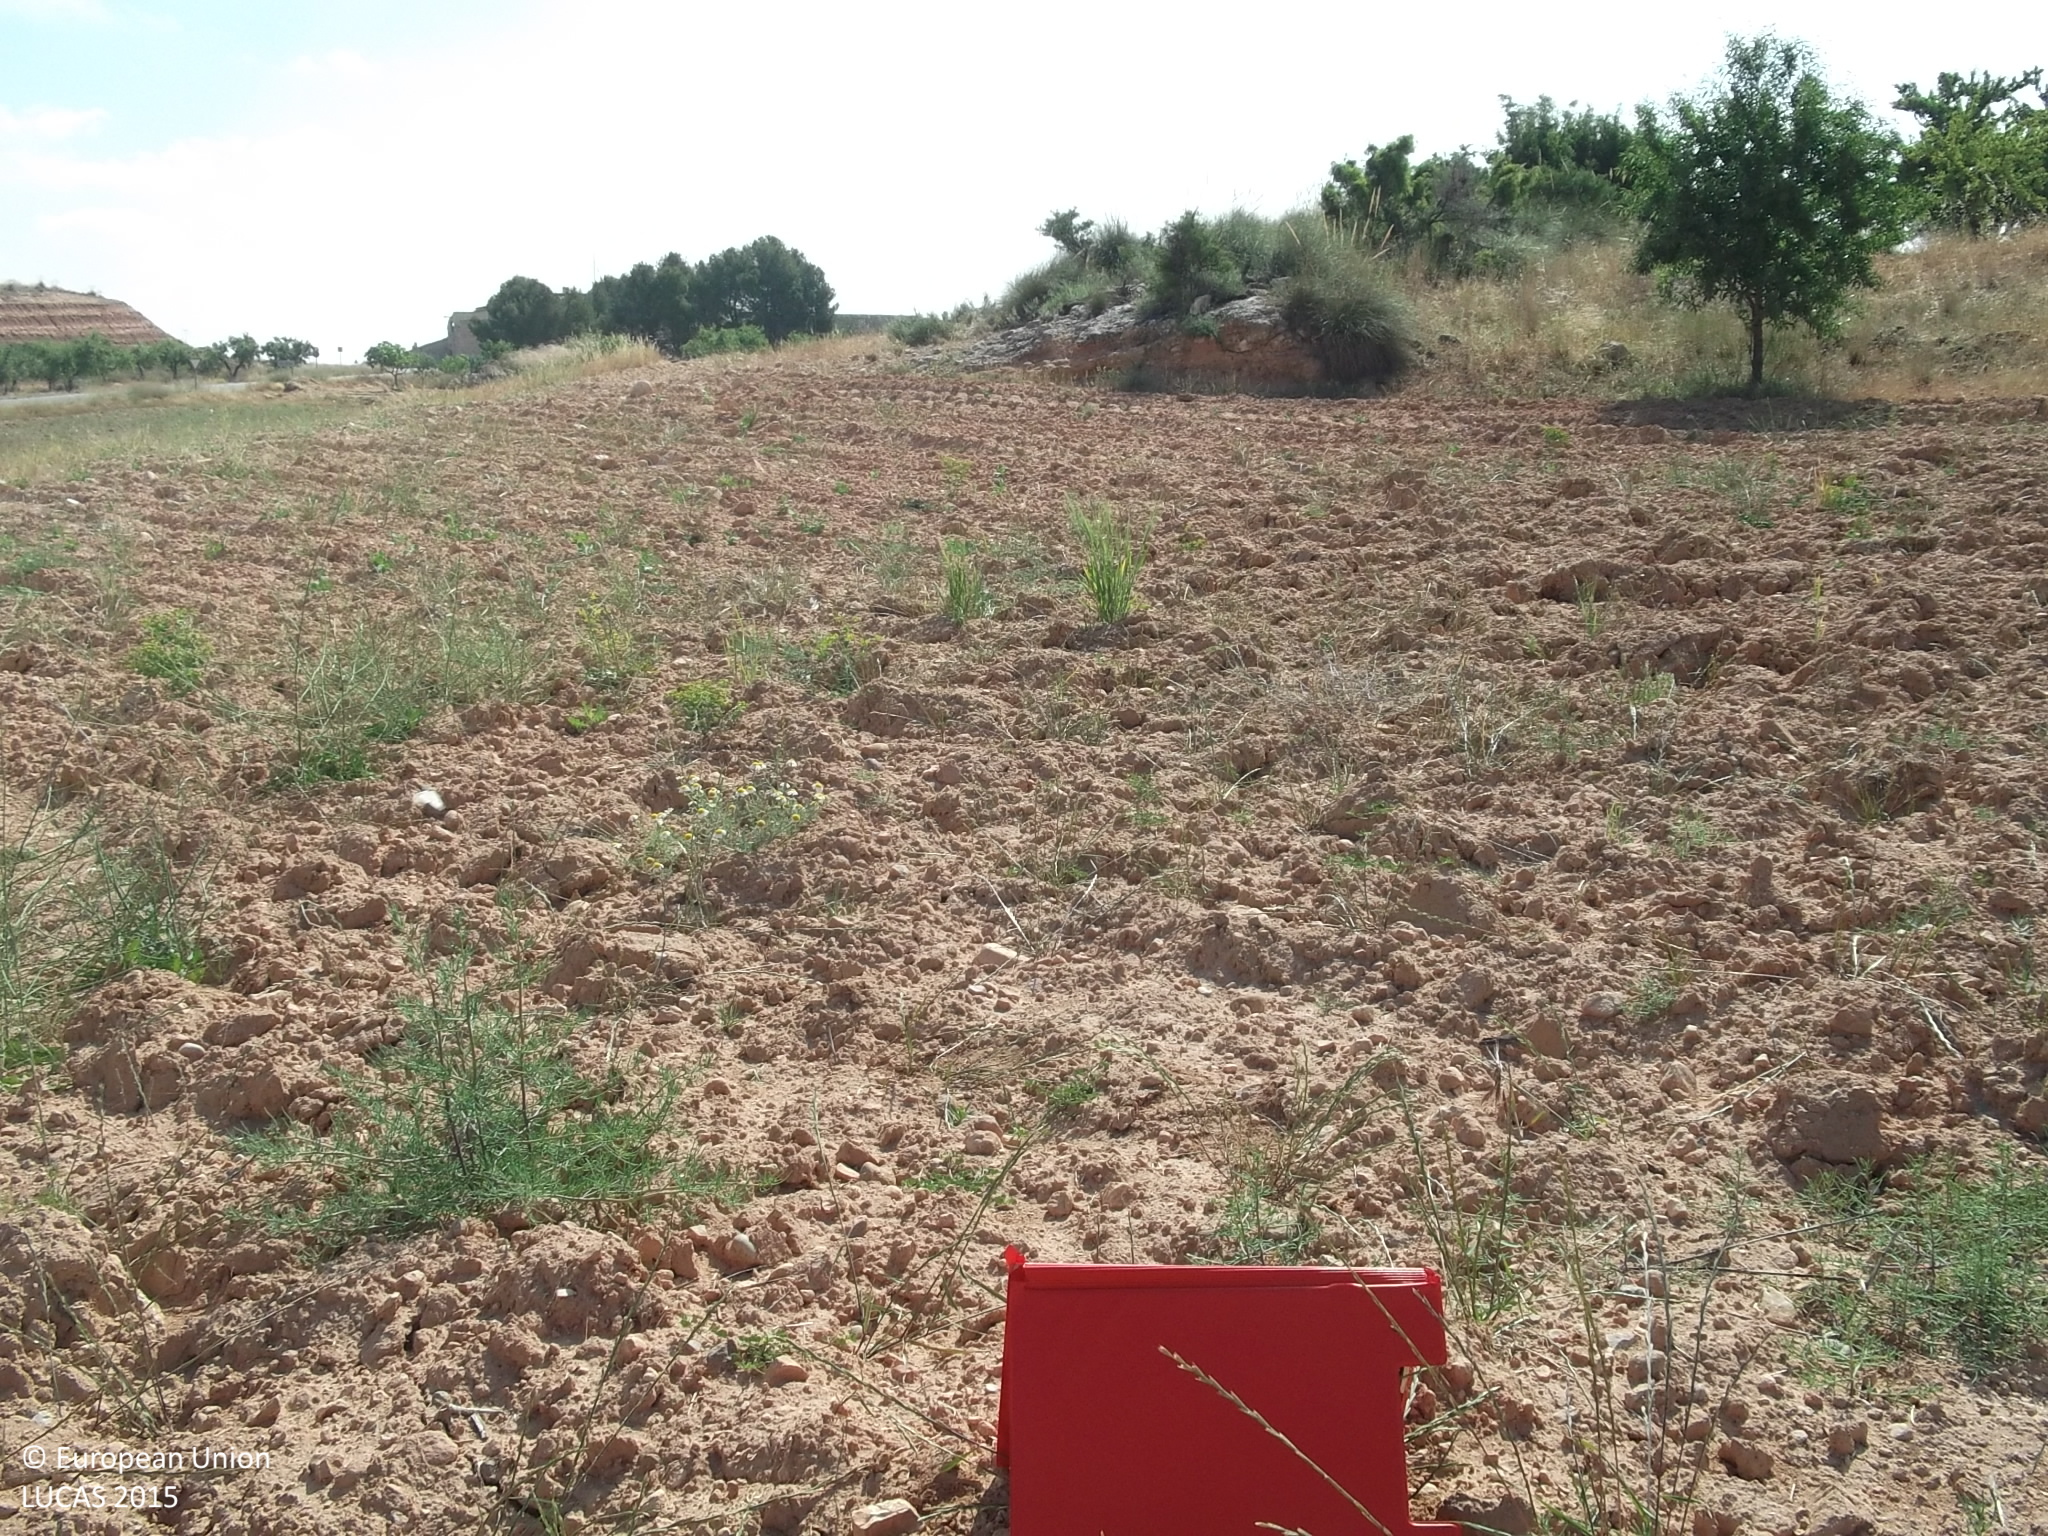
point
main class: Grassland
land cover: Spontaneously vegetated surfaces
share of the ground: 25 - 50 %
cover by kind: unconsolidated bare surface 75 %, herbaceous plants 25 %
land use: Fallow land
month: May
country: ES
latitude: 38.4604
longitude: -1.4629
